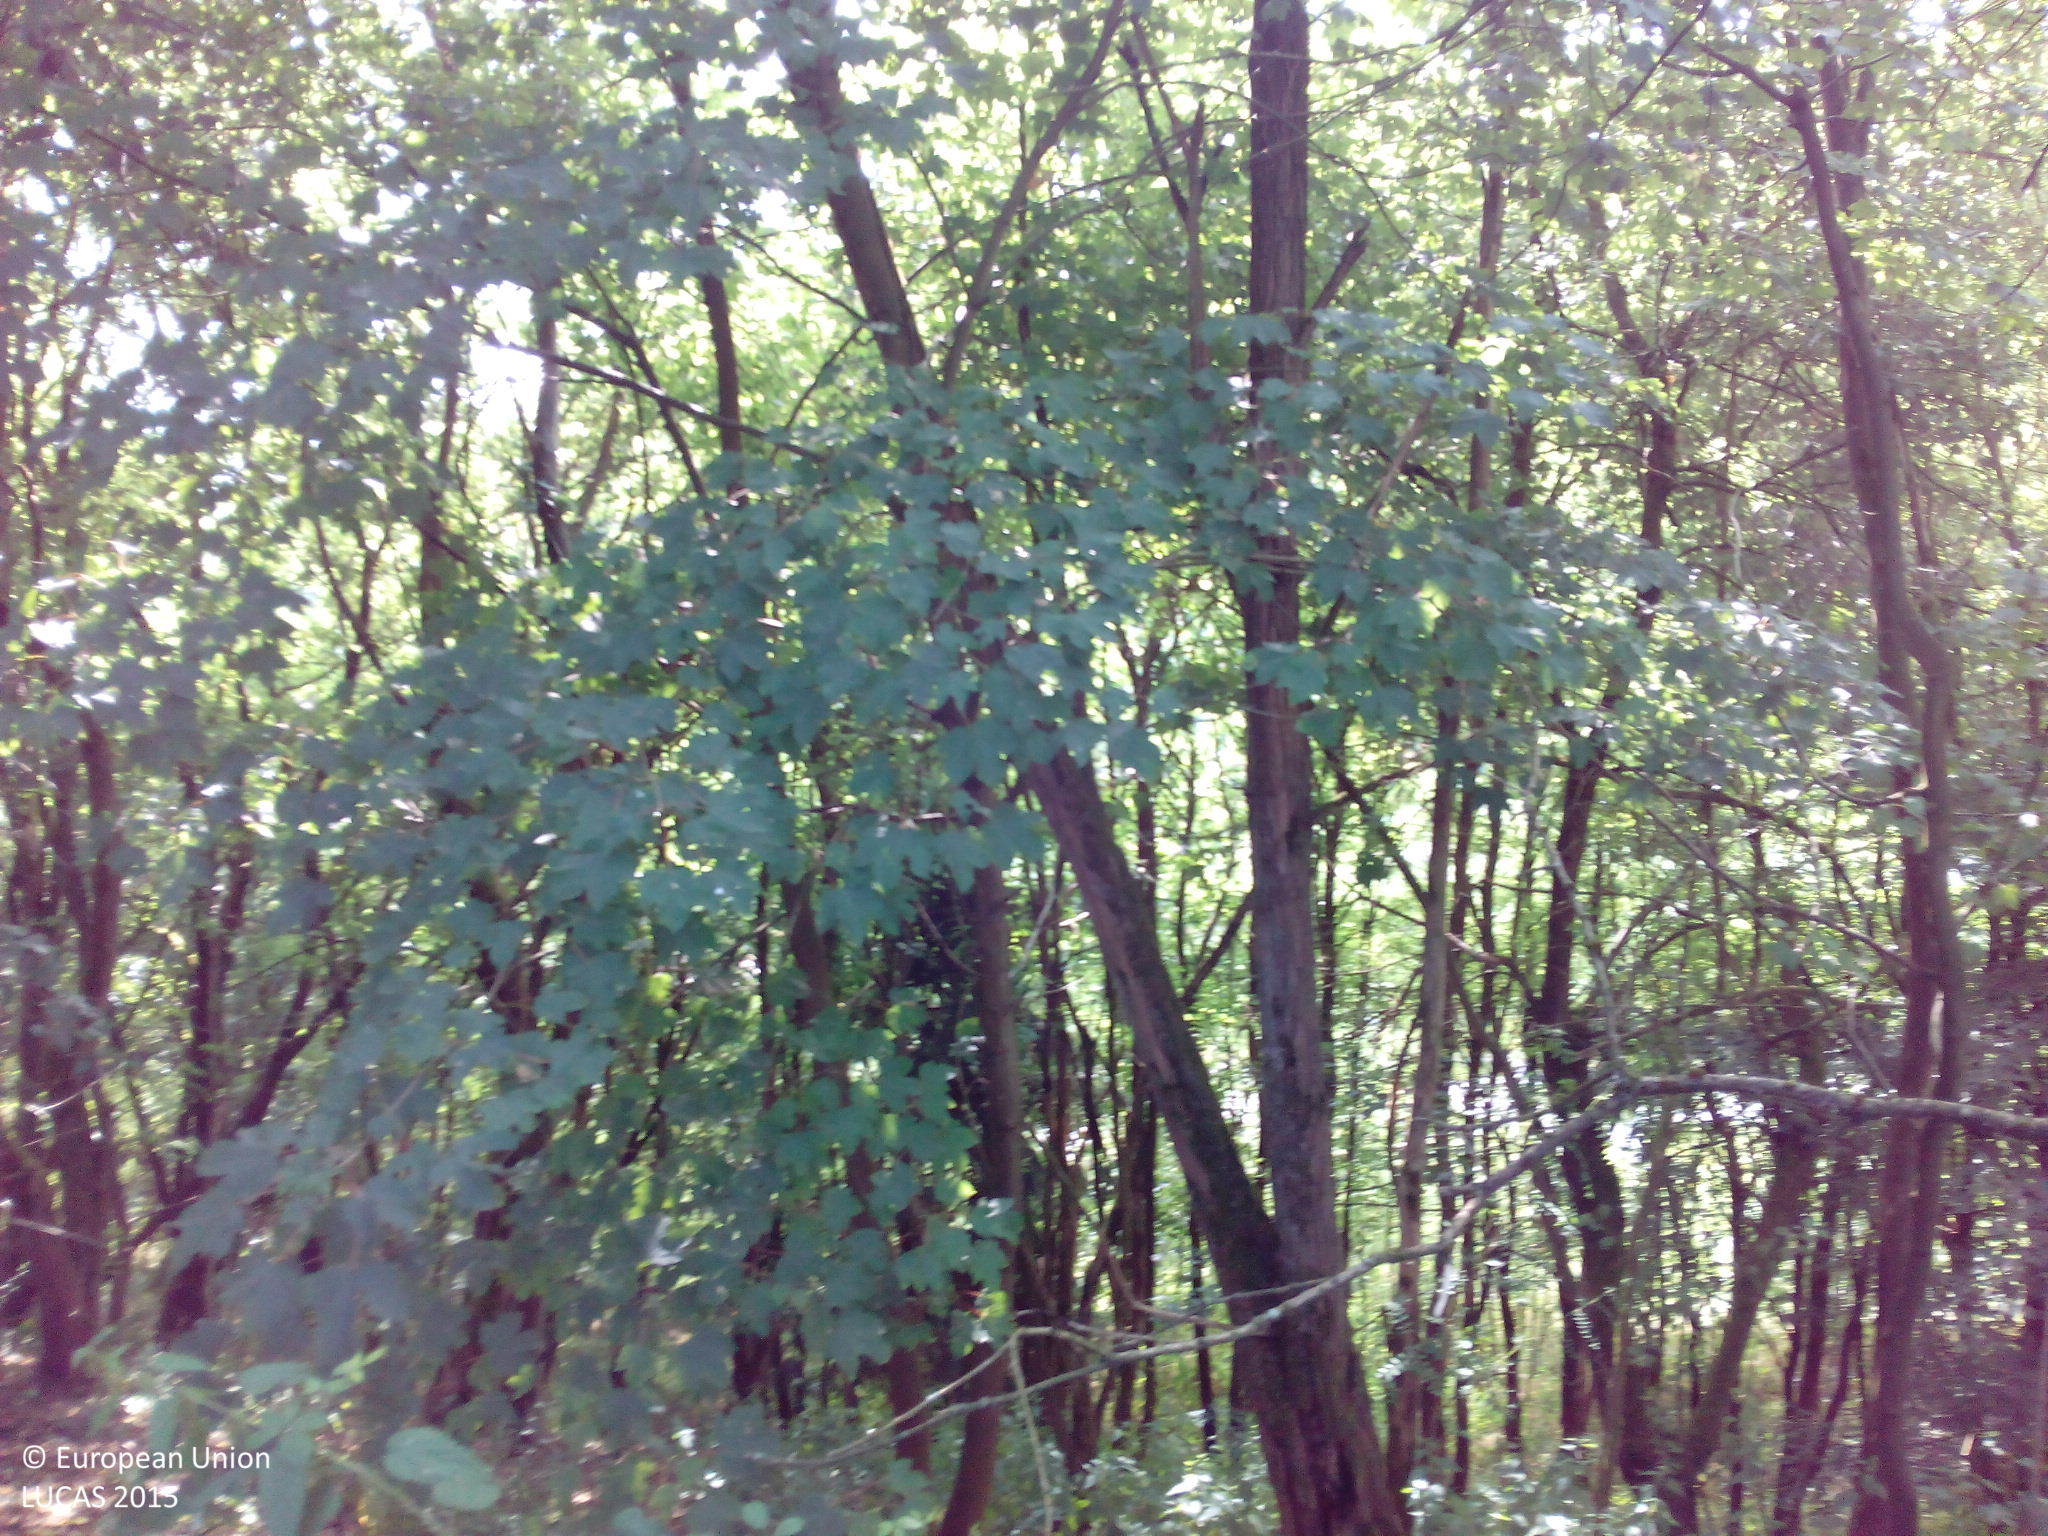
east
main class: Woodland
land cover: Broadleaved woodland
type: mesophytic deciduous forest
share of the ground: > 75 %
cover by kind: broadleaved forest trees 100 %
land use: Forestry
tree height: > 5 m
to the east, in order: Broadleaved woodland; Grass margins; Tracks; Grass margins; Paved roads, cycling and walking lanes; Grass margins; Broadleaved woodland; Electric lines; Railways; Electric lines; Broadleaved woodland; Inland fresh running water; Broadleaved woodland; Grassland without tree/shrub cover; Paved roads, cycling and walking lanes; Grassland without tree/shrub cover; Broadleaved woodland
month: July
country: DE
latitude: 49.4467
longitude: 7.1452
